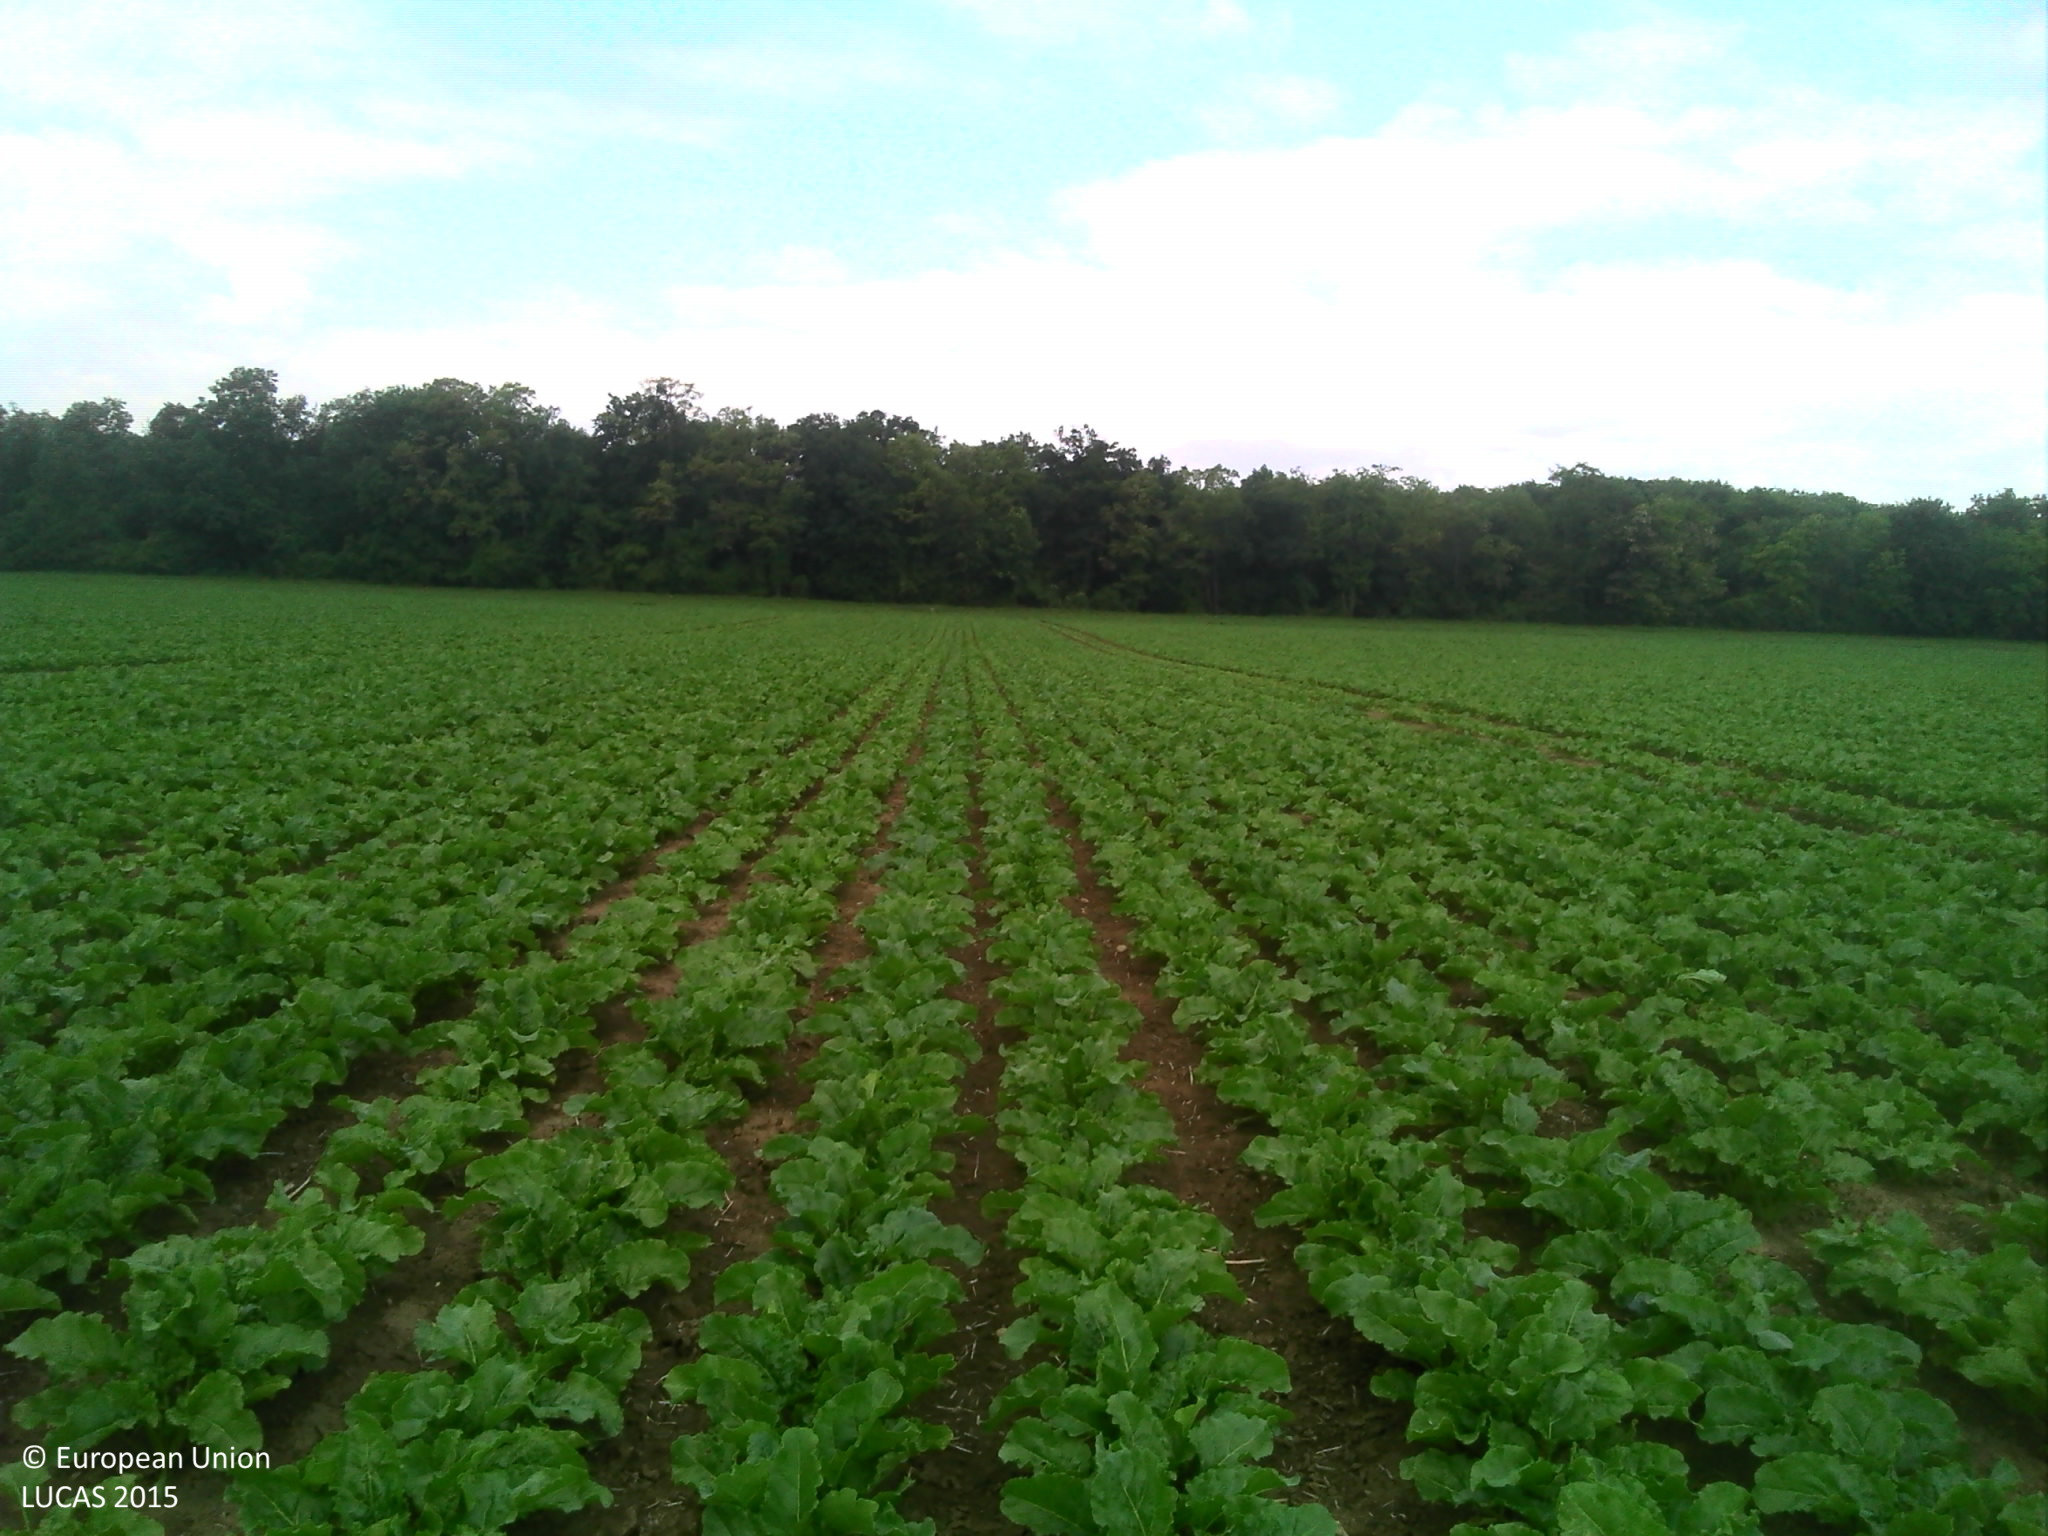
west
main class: Cropland
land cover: Sugar beet
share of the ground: > 75 %
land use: Agriculture (excluding fallow land and kitchen gardens)
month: May
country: FR
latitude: 48.1973
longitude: 7.5928
